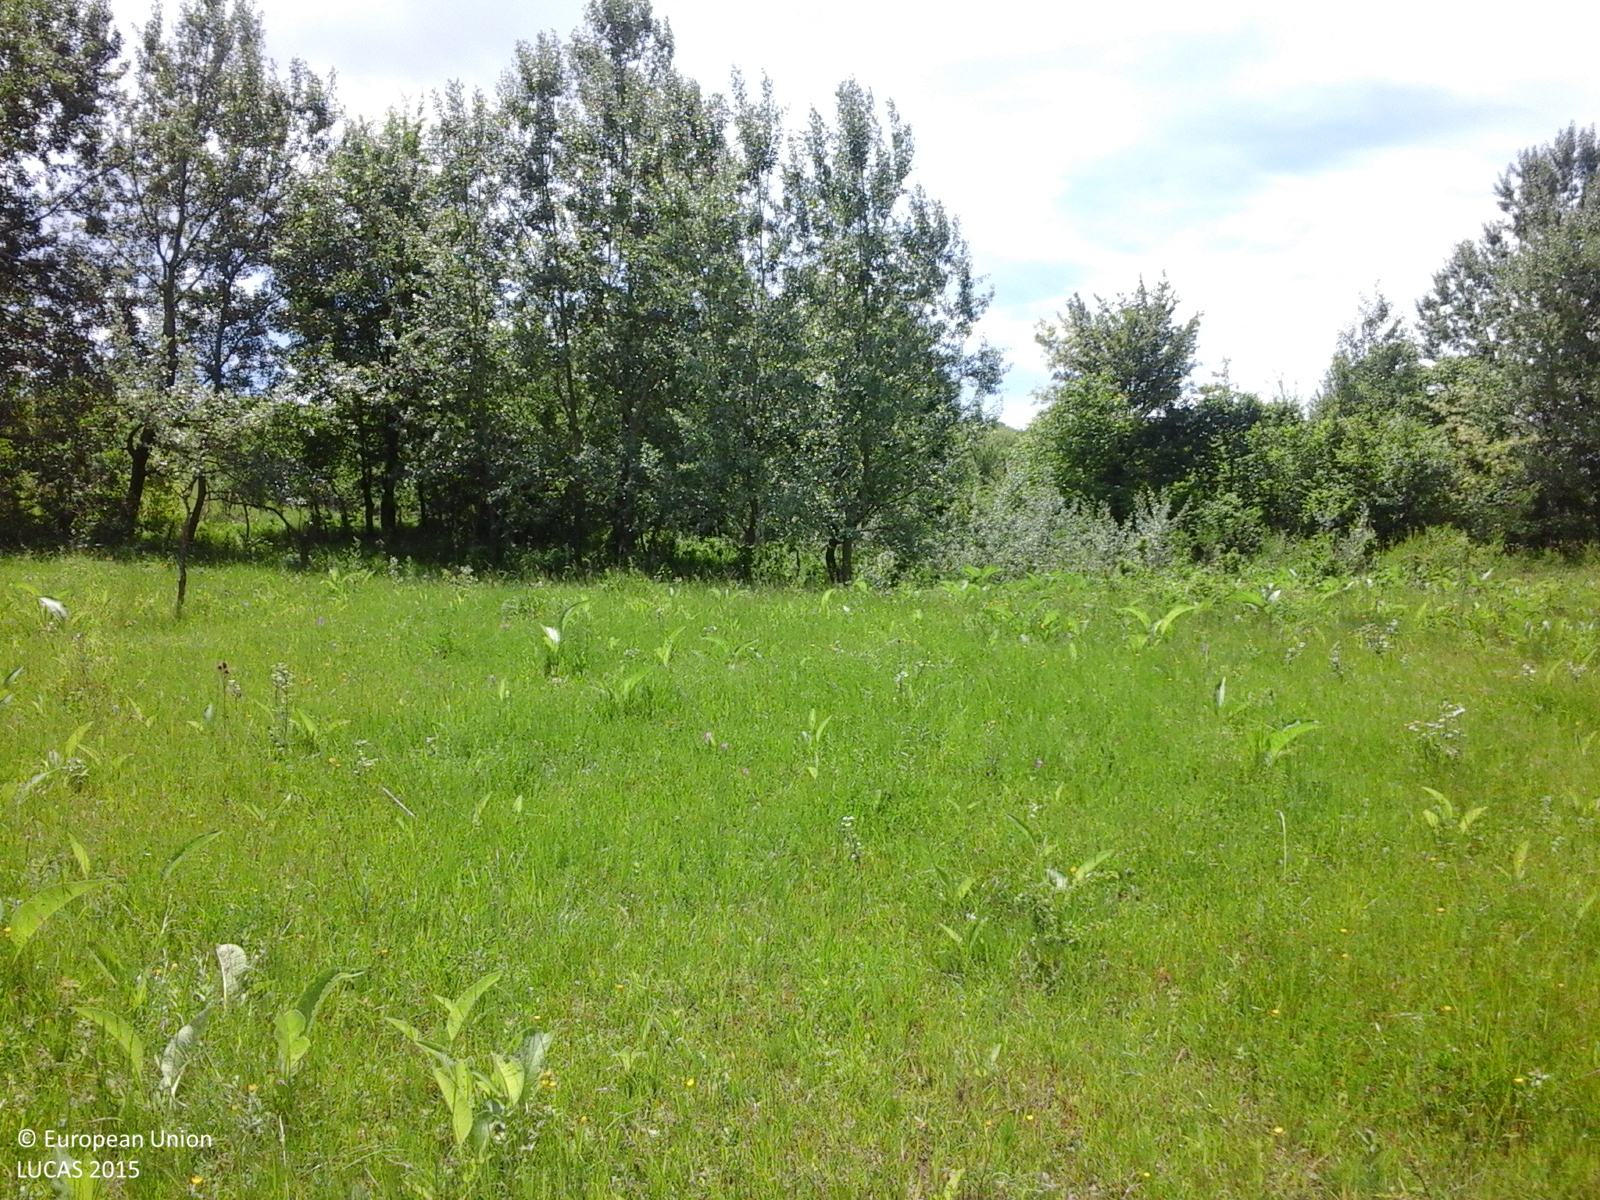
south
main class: Grassland
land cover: Grassland without tree/shrub cover
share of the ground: > 75 %
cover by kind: herbaceous plants 100 %
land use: Agriculture (excluding fallow land and kitchen gardens)
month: May
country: RO
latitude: 45.1577
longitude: 26.1023
